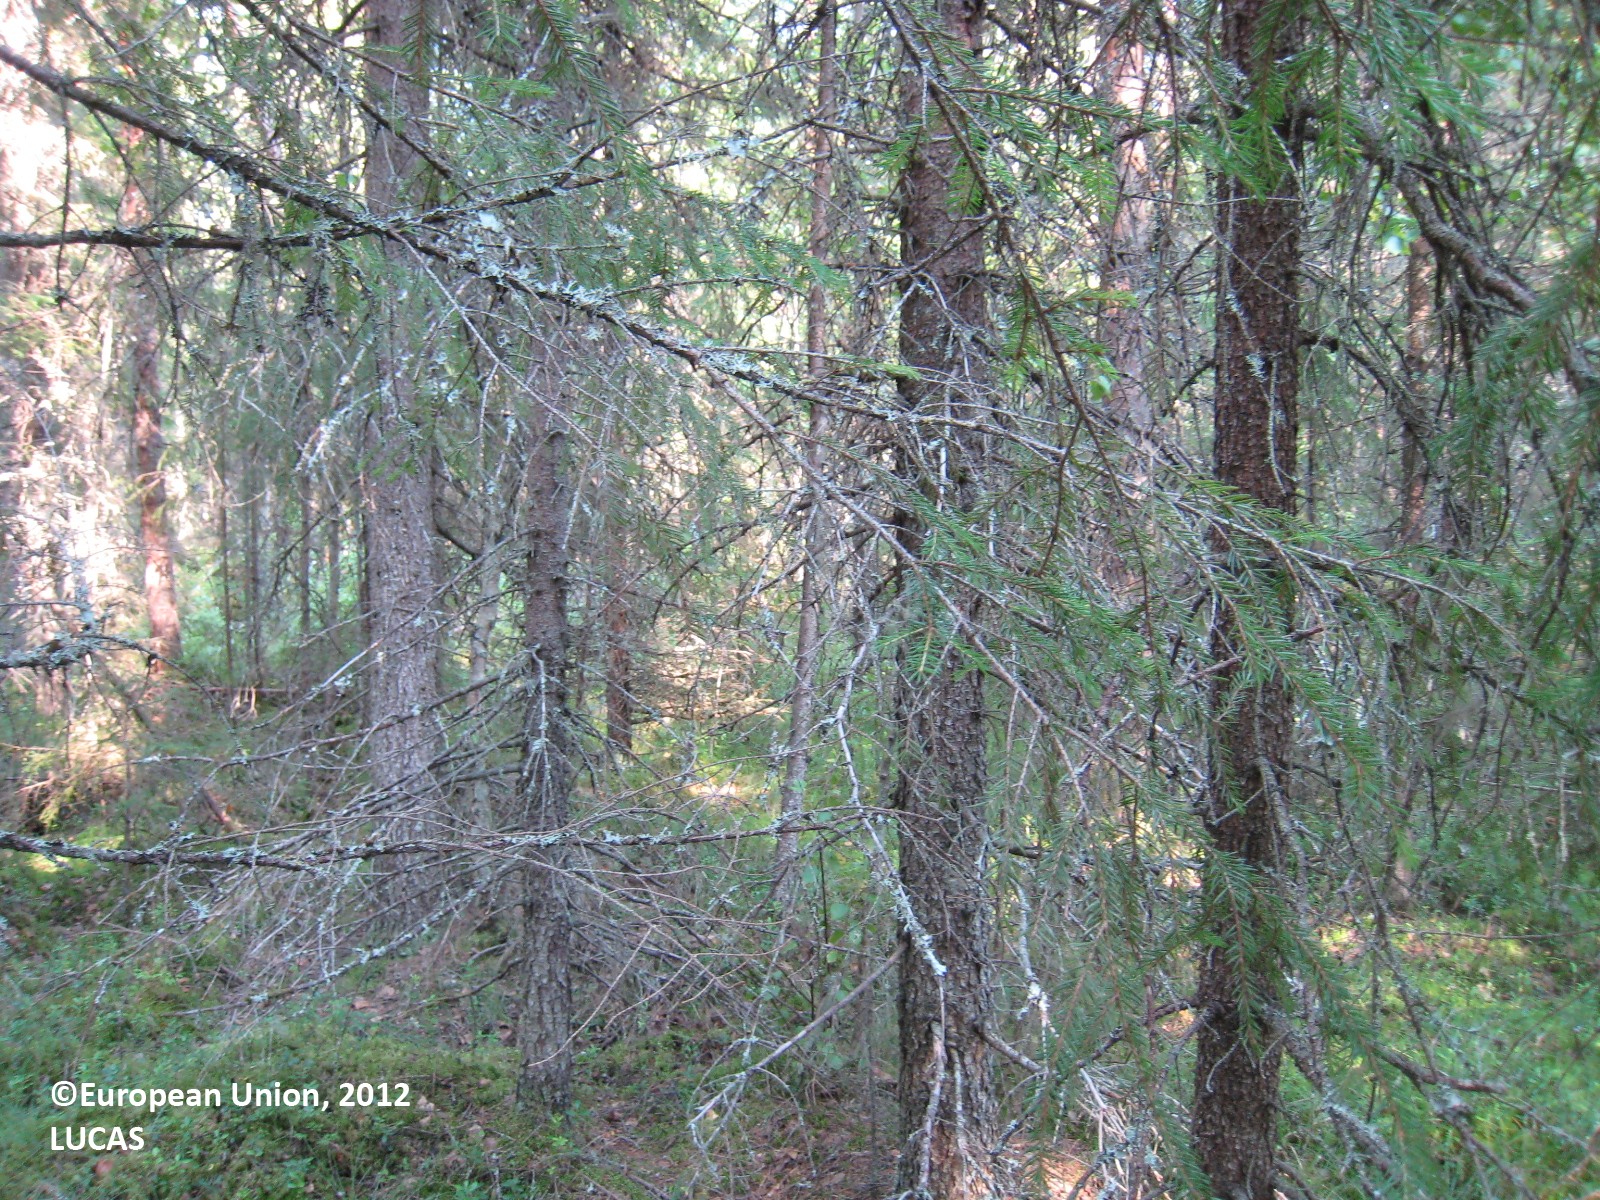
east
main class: Woodland
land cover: Other mixed woodland
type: boreal forest
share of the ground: > 75 %
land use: Forestry
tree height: > 5 m
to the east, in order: Other mixed woodland; Ditches and canals; Other mixed woodland; Ditches and canals; Other mixed woodland; Spruce dominated mixed woodland; Ditches and canals; Spruce dominated mixed woodland; Rivers and streams; Other coniferous woodland; Grassland with sparse tree/shrub cover; Artificial constructions in urban areas
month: July
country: FI
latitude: 62.6154
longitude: 27.3295
